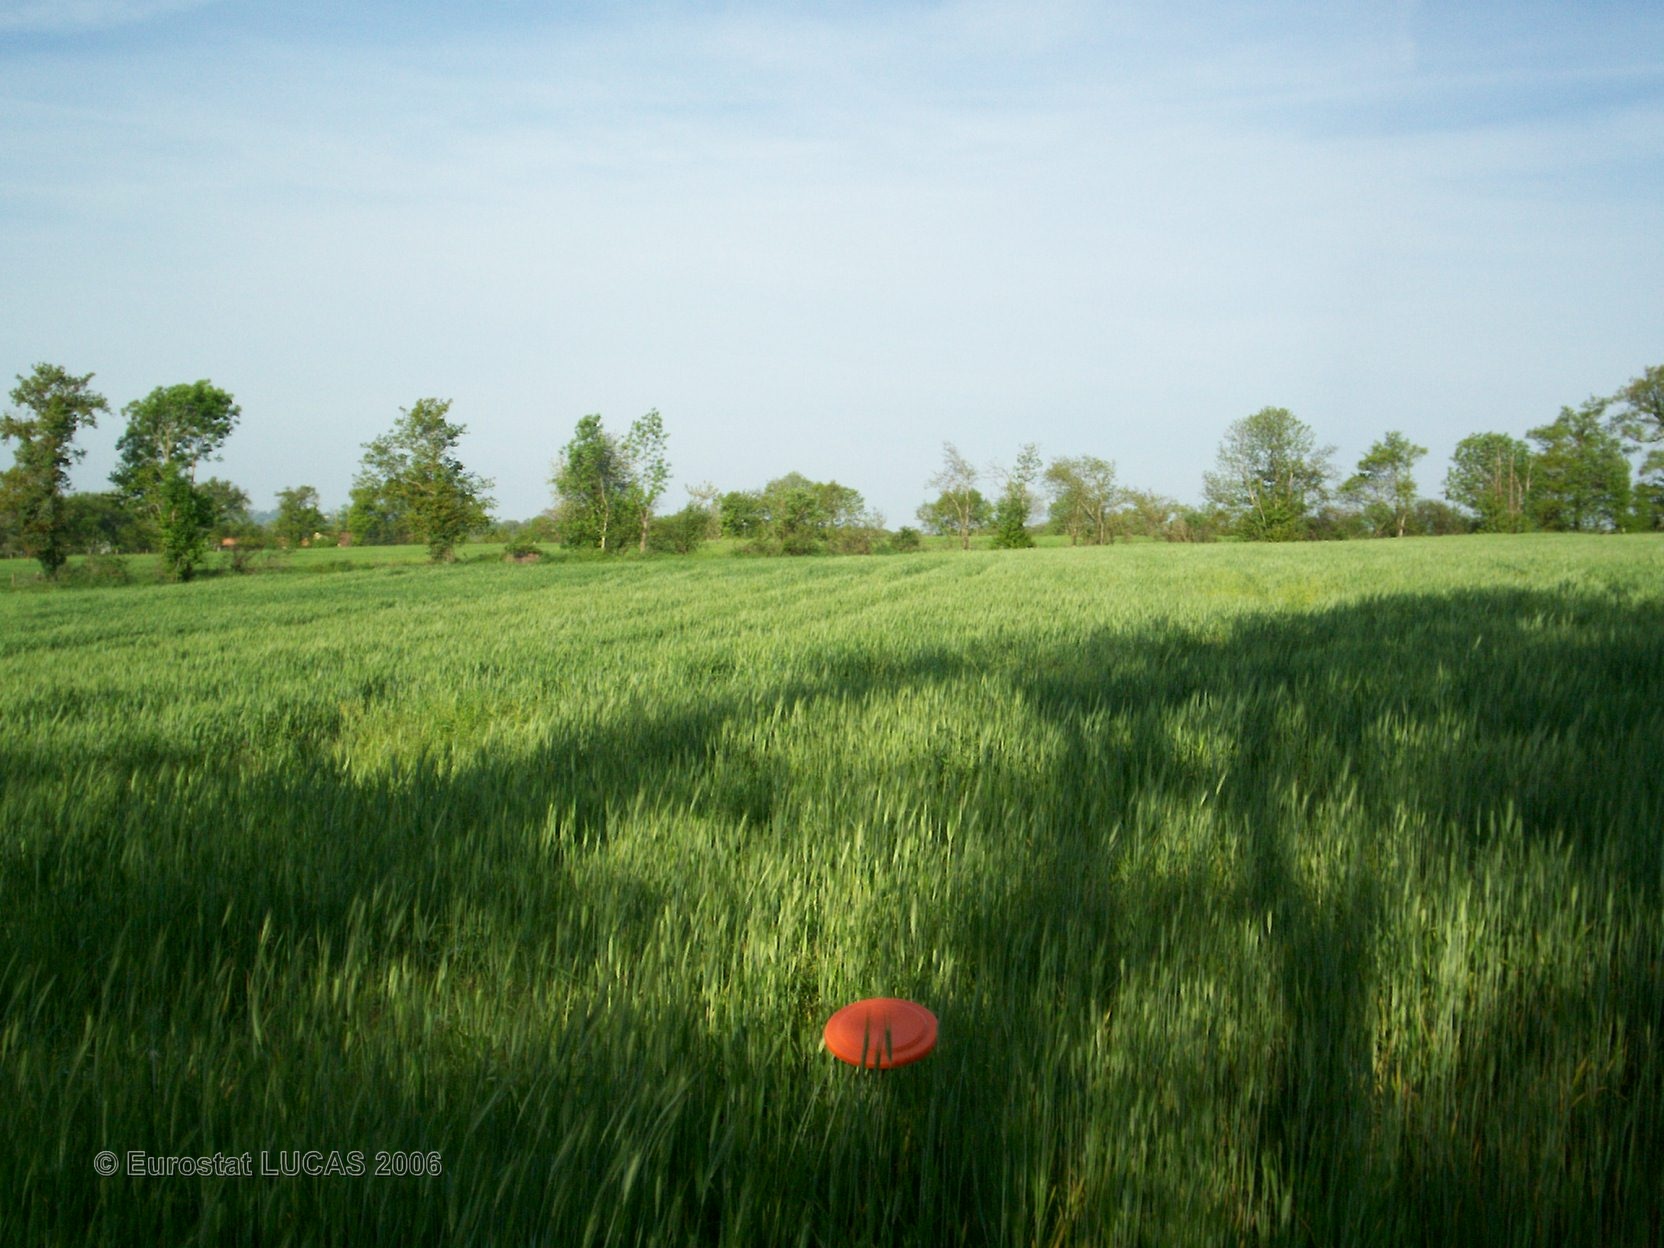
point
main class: Cropland
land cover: Common wheat
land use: Agriculture (excluding fallow land and kitchen gardens)
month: May
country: FR
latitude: 45.9083
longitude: 0.6921
